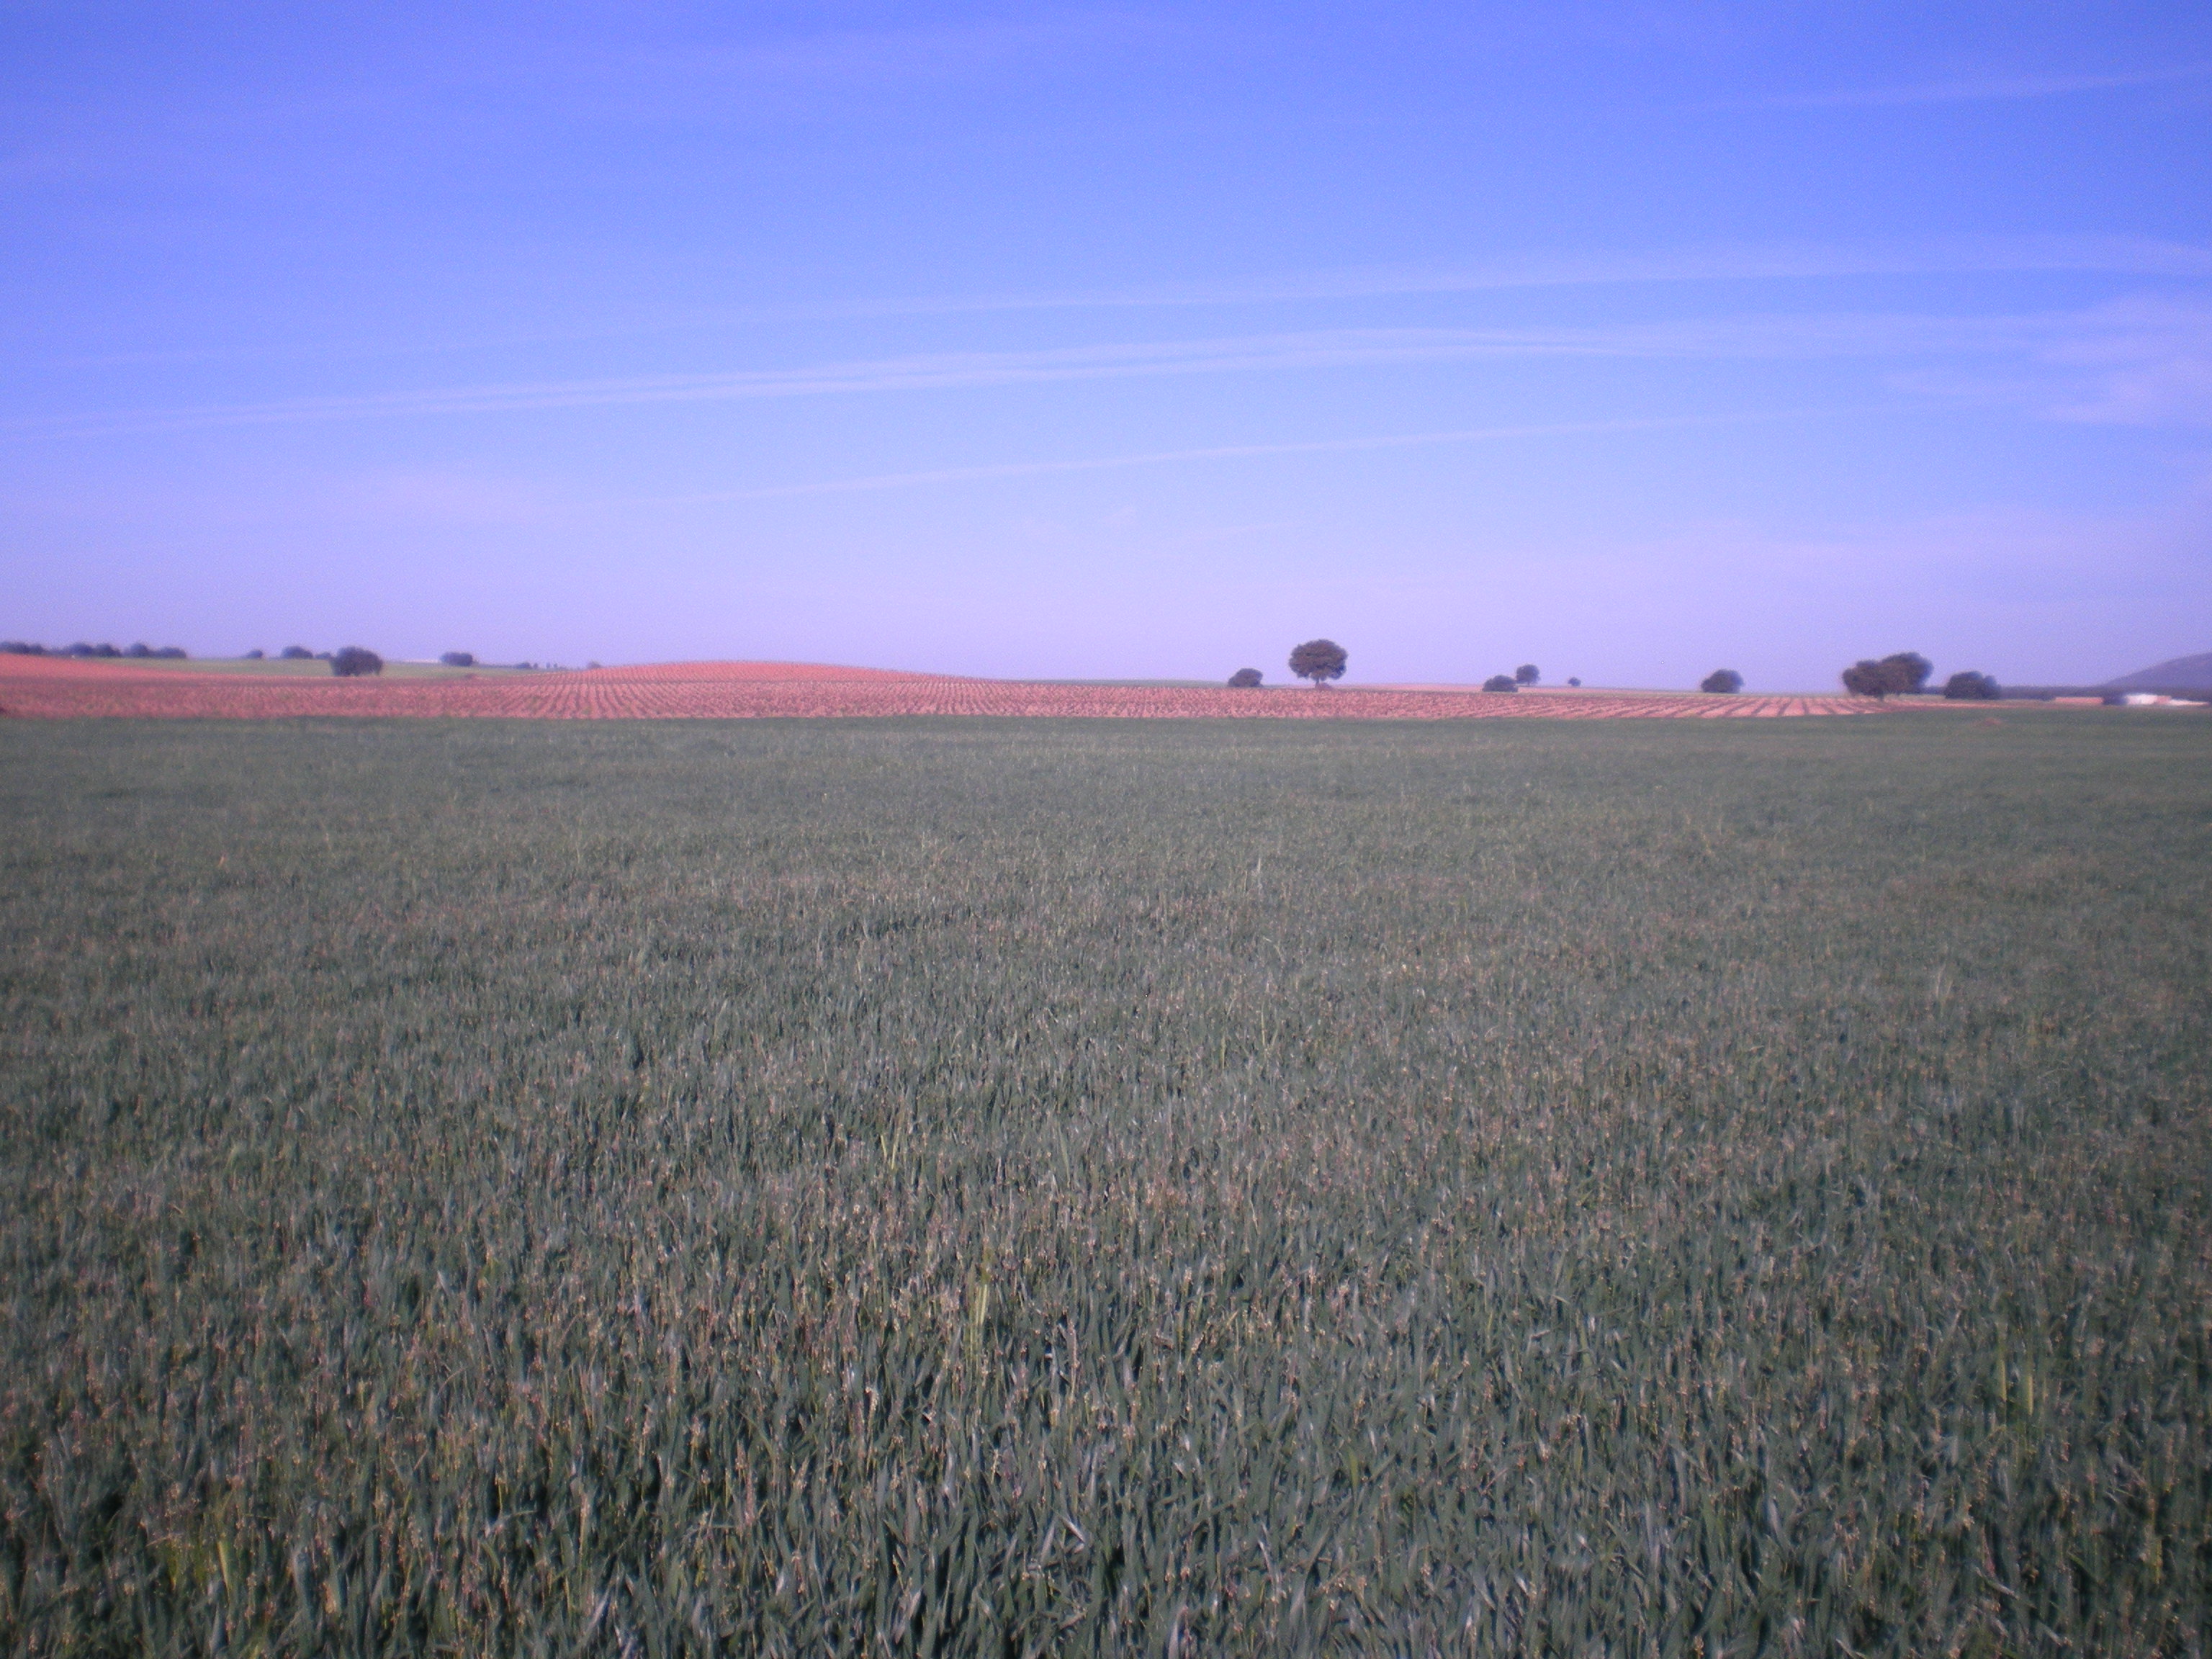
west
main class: Cropland
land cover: Durum wheat
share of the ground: > 75 %
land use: Agriculture (excluding fallow land and kitchen gardens)
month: April
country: ES
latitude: 38.7801
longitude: -3.2360
